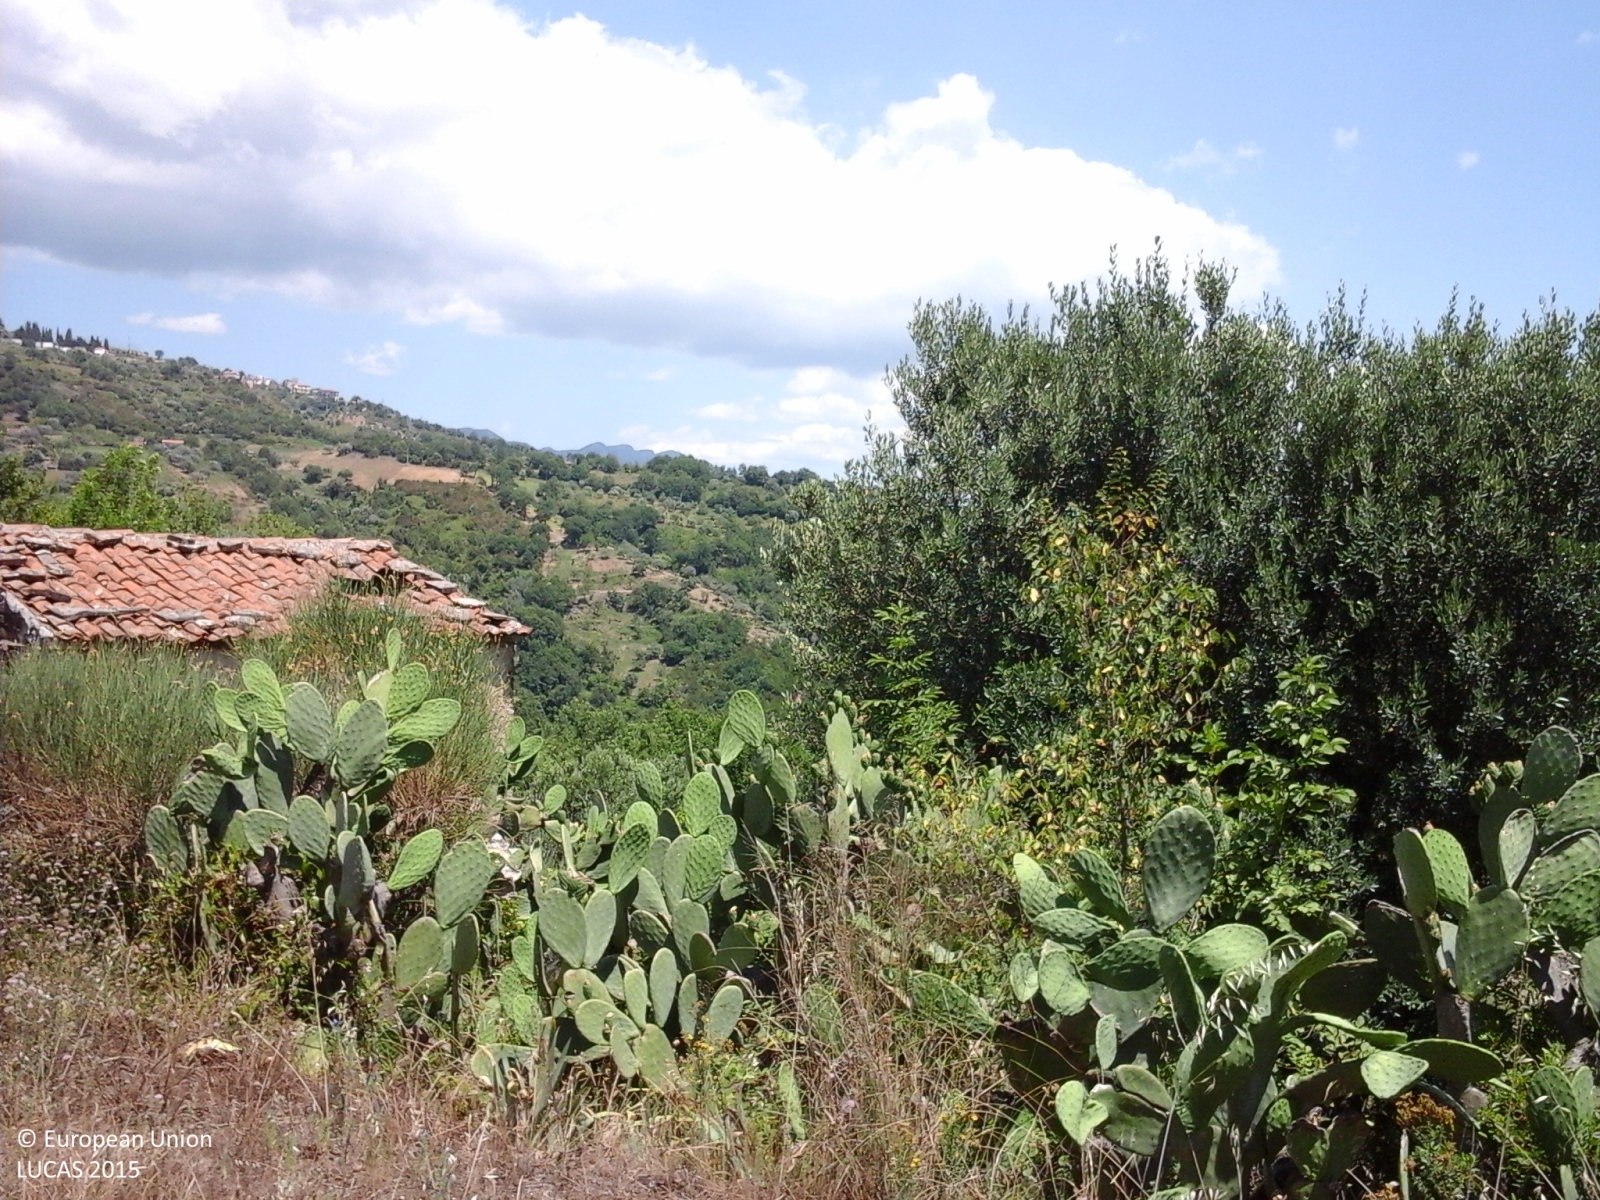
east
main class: Shrubland
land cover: Shrubland with sparse tree cover
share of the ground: > 75 %
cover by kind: shrubs 85 %, broadleaved forest trees 5 %
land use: Semi-natural and natural areas not in use
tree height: > 5 m
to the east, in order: Shrubland with sparse tree cover; Tracks; Shrubland with sparse tree cover; Tracks; Shrubland with sparse tree cover; Broadleaved woodland; Tracks; Permanent crops (only in case pi); Shrubland without tree cover; Permanent crops (only in case pi)
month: June
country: IT
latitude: 40.3342
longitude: 15.0981
